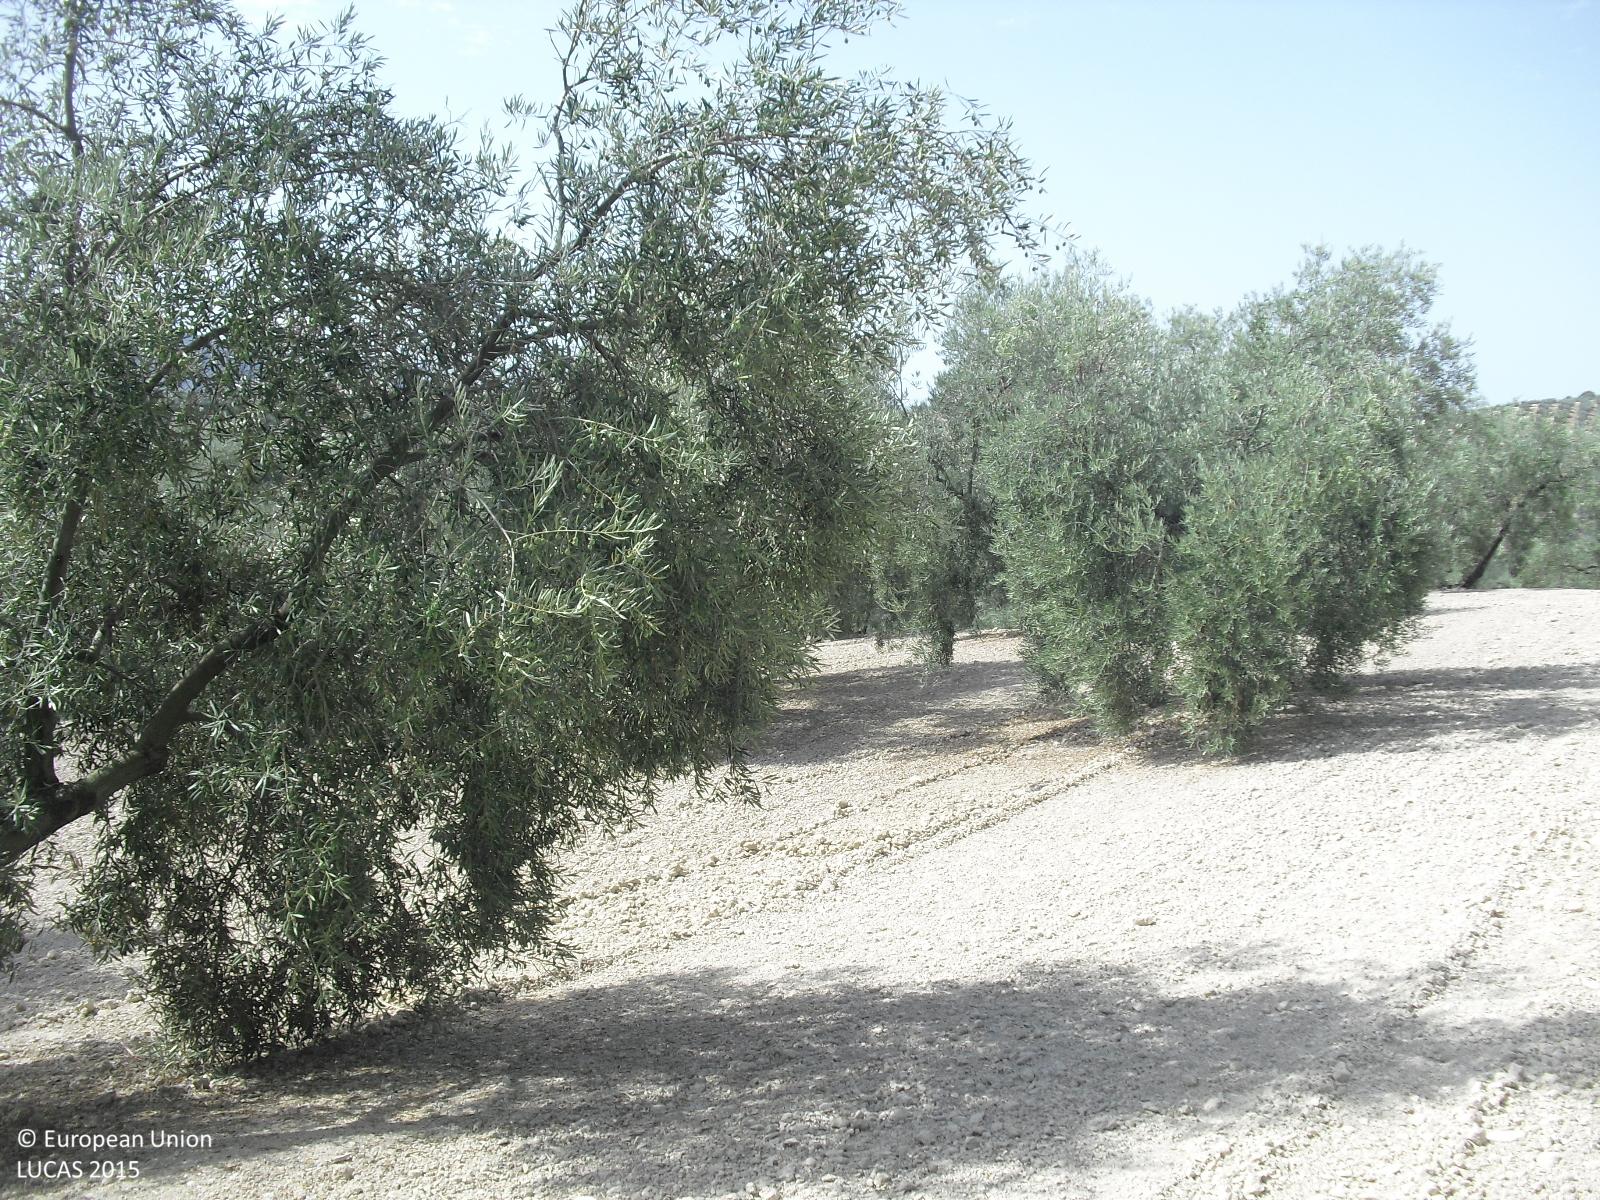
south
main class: Cropland
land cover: Olive groves
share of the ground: 25 - 50 %
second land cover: Other bare soil
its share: > 75 %
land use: Agriculture (excluding fallow land and kitchen gardens)
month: July
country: ES
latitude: 37.1602
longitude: -4.3997
